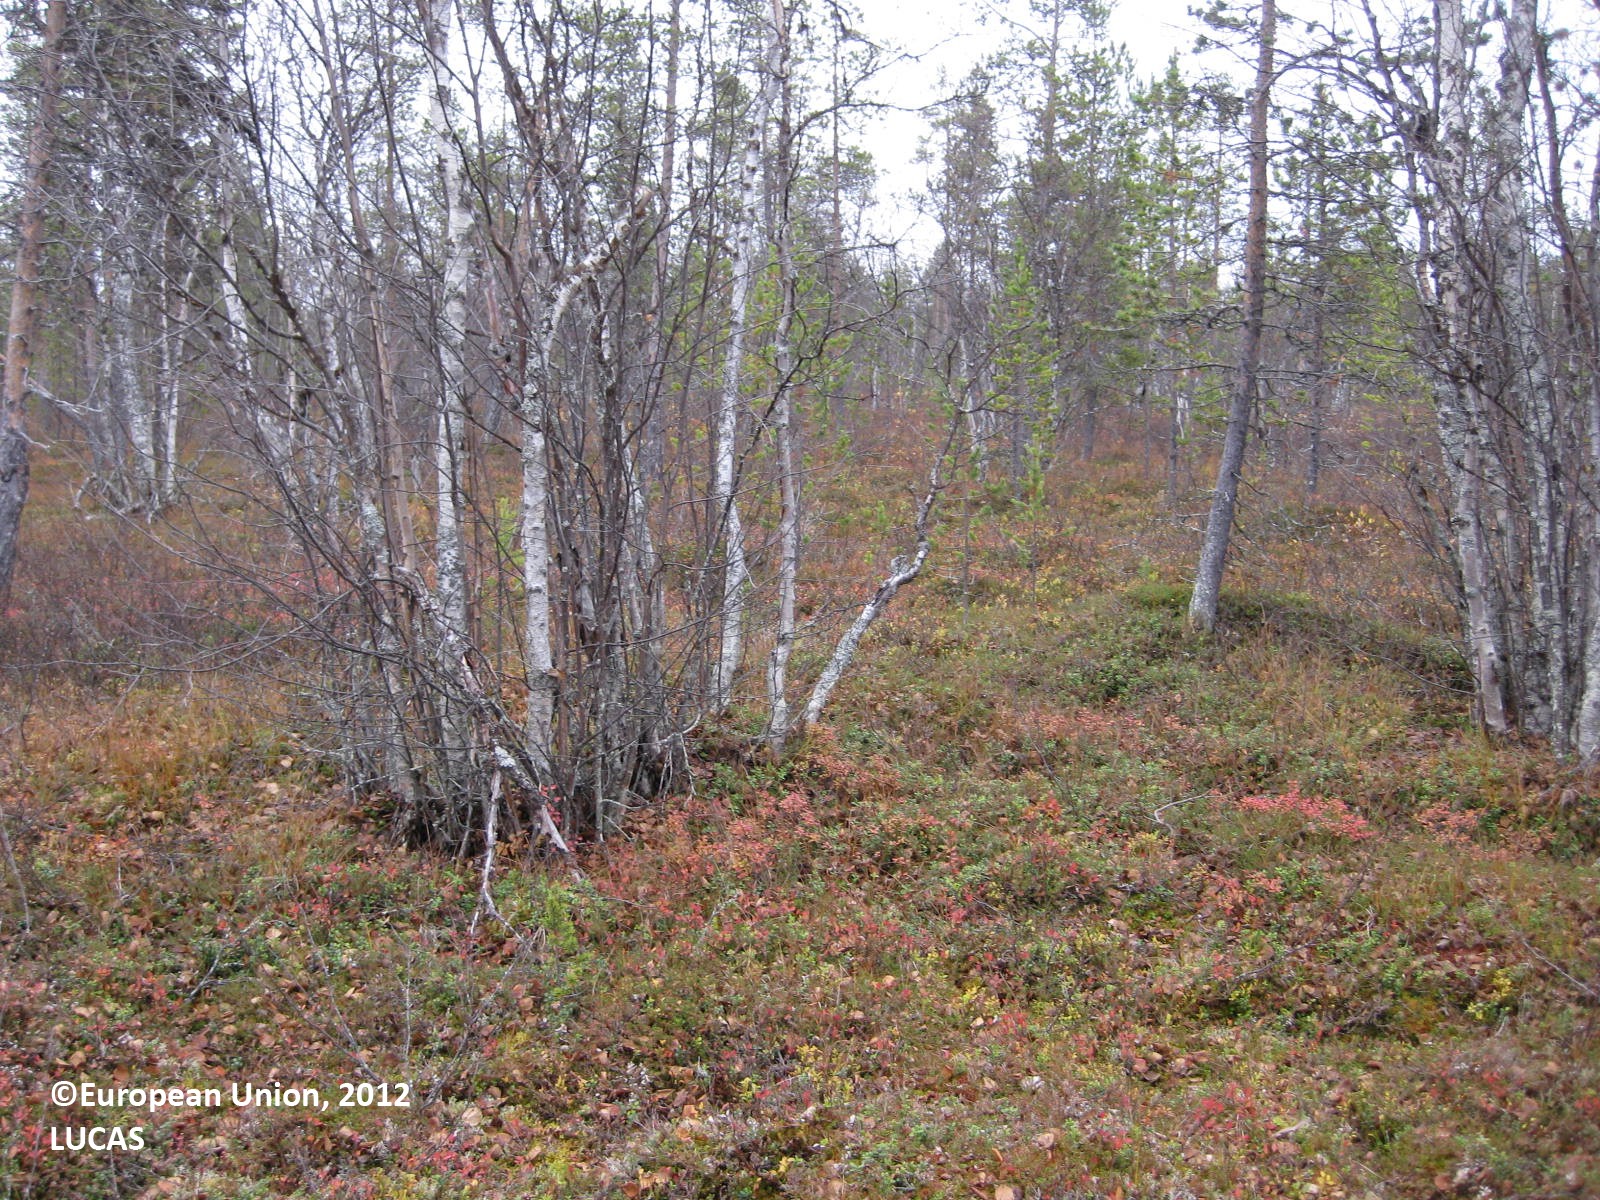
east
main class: Woodland
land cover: Other mixed woodland
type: boreal forest
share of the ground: > 75 %
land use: Forestry
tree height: > 5 m
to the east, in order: Other mixed woodland
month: September
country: FI
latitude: 68.0828
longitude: 23.6212
